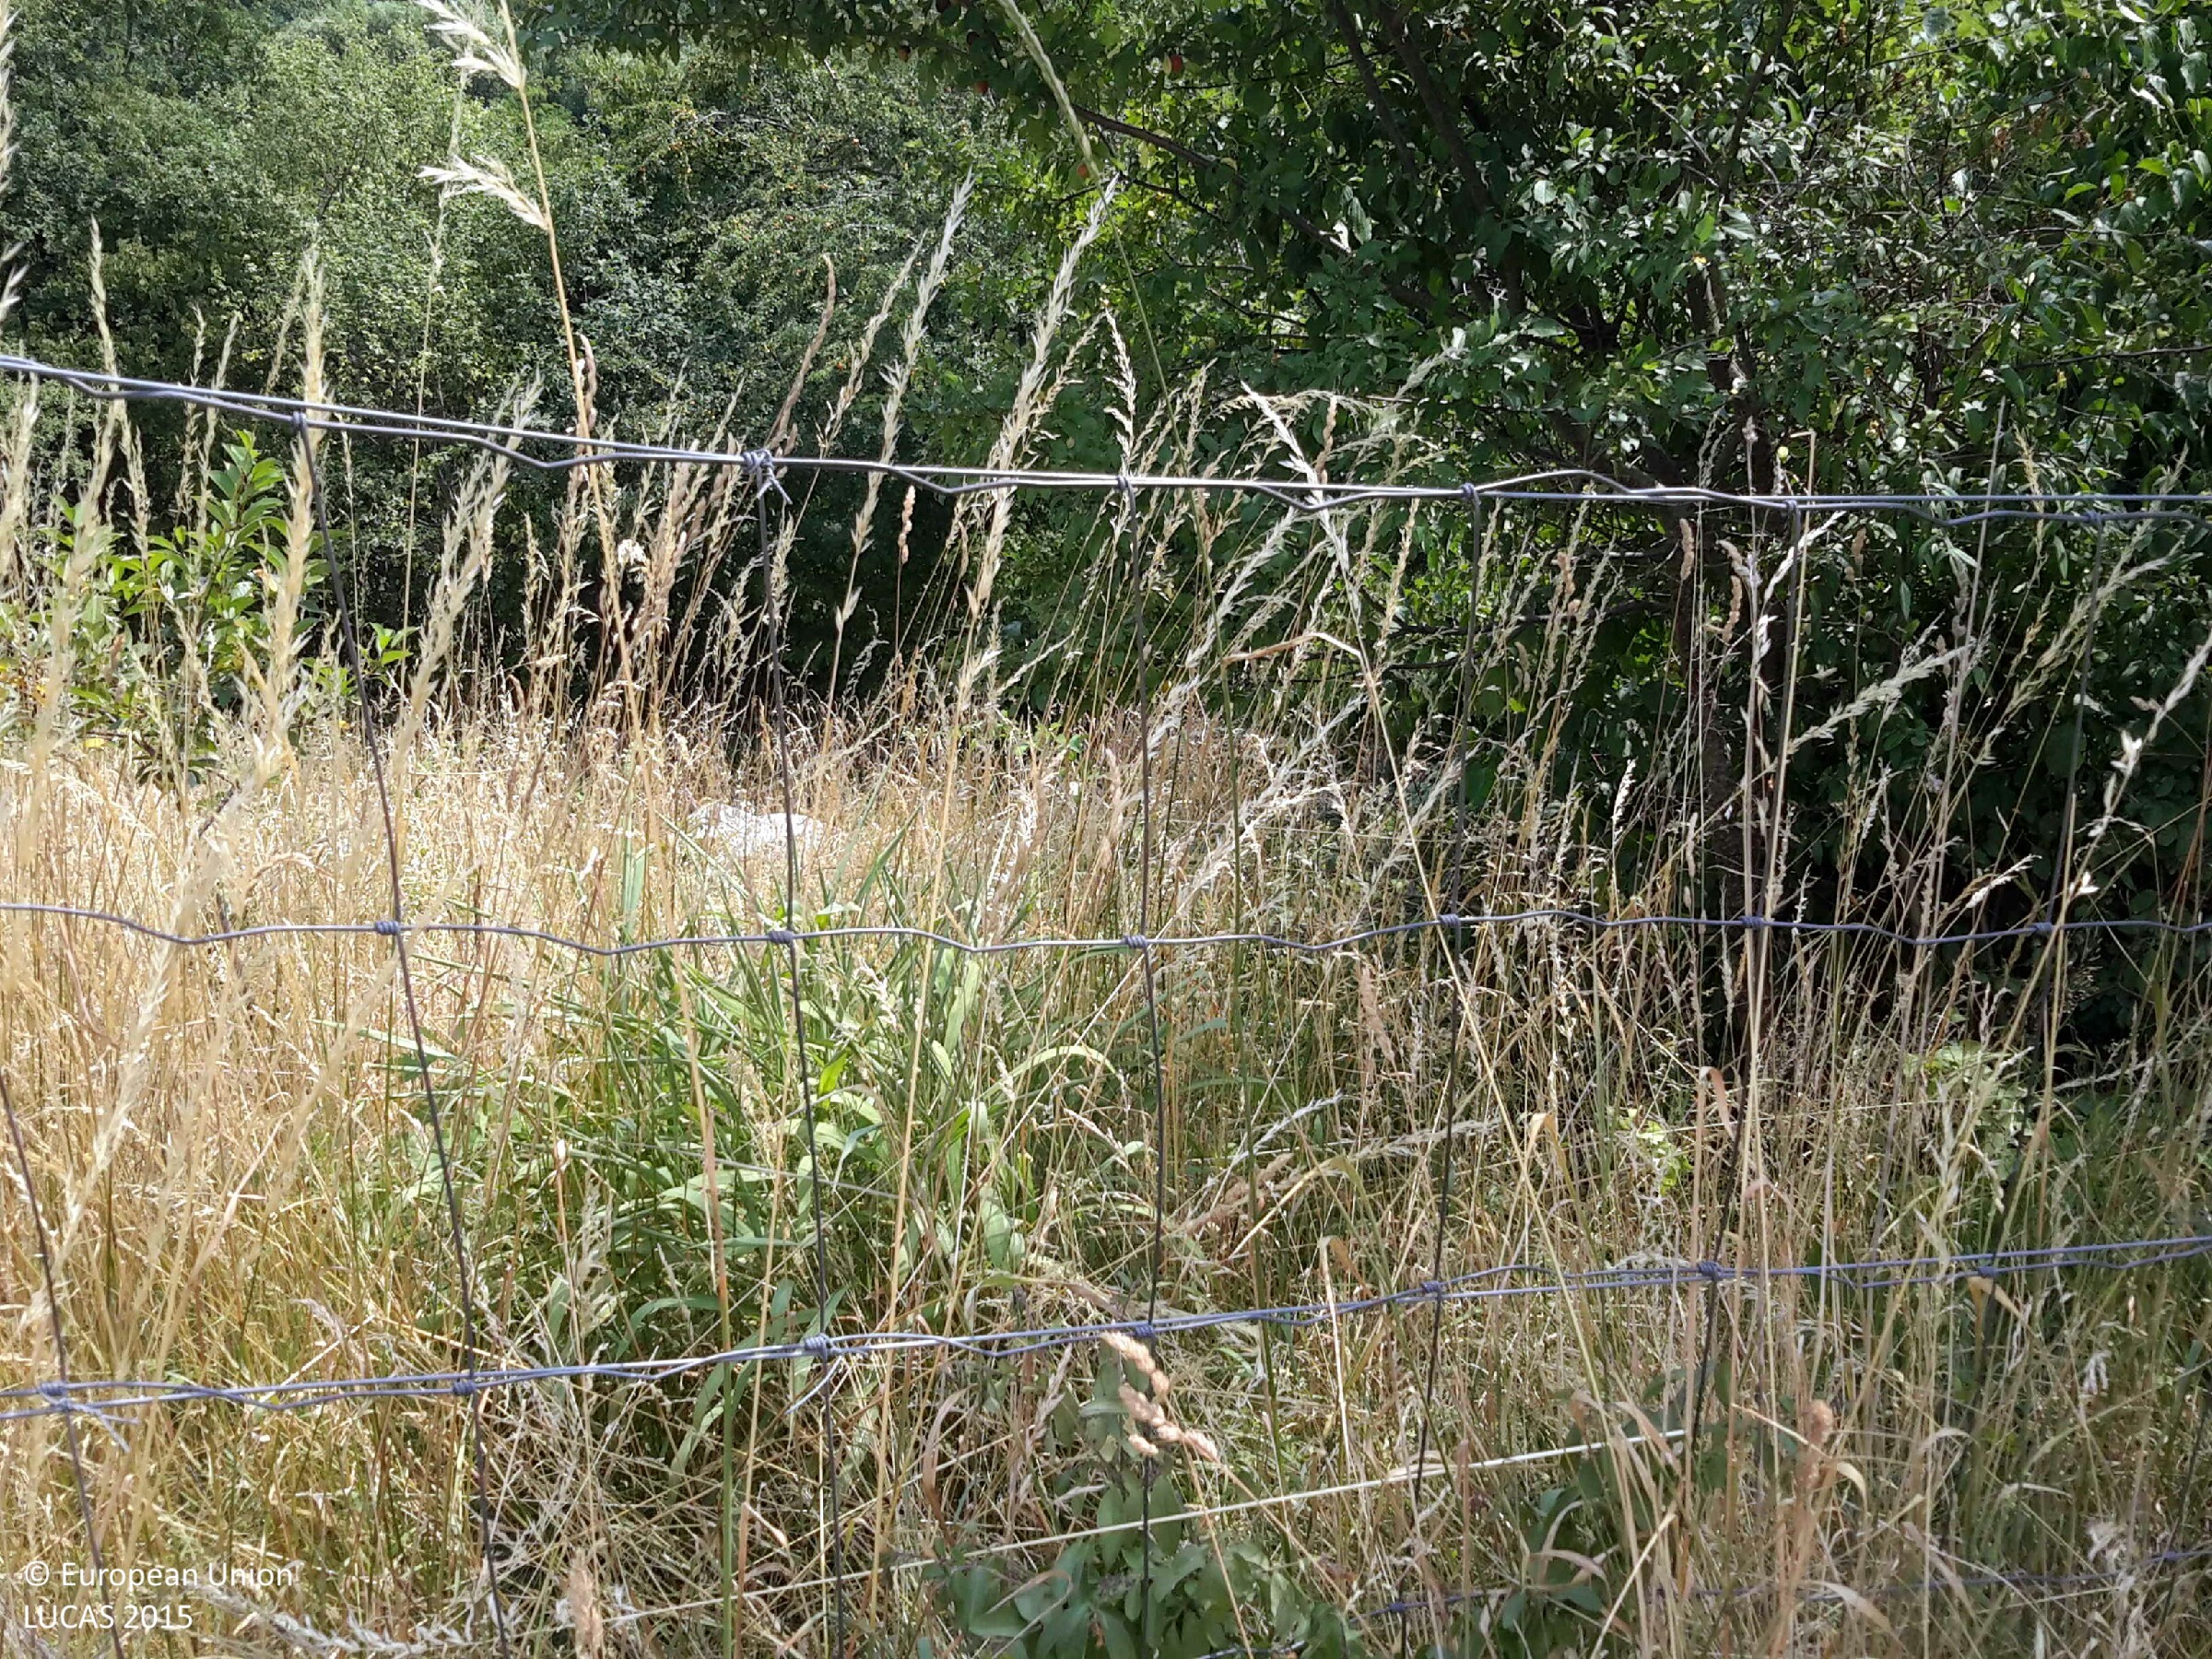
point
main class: Cropland
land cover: Other fruit trees and berries
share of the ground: 25 - 50 %
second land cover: Spontaneously vegetated surfaces
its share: 50 - 75 %
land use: Abandoned areas
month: July
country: HU
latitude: 47.6533
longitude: 16.4880
